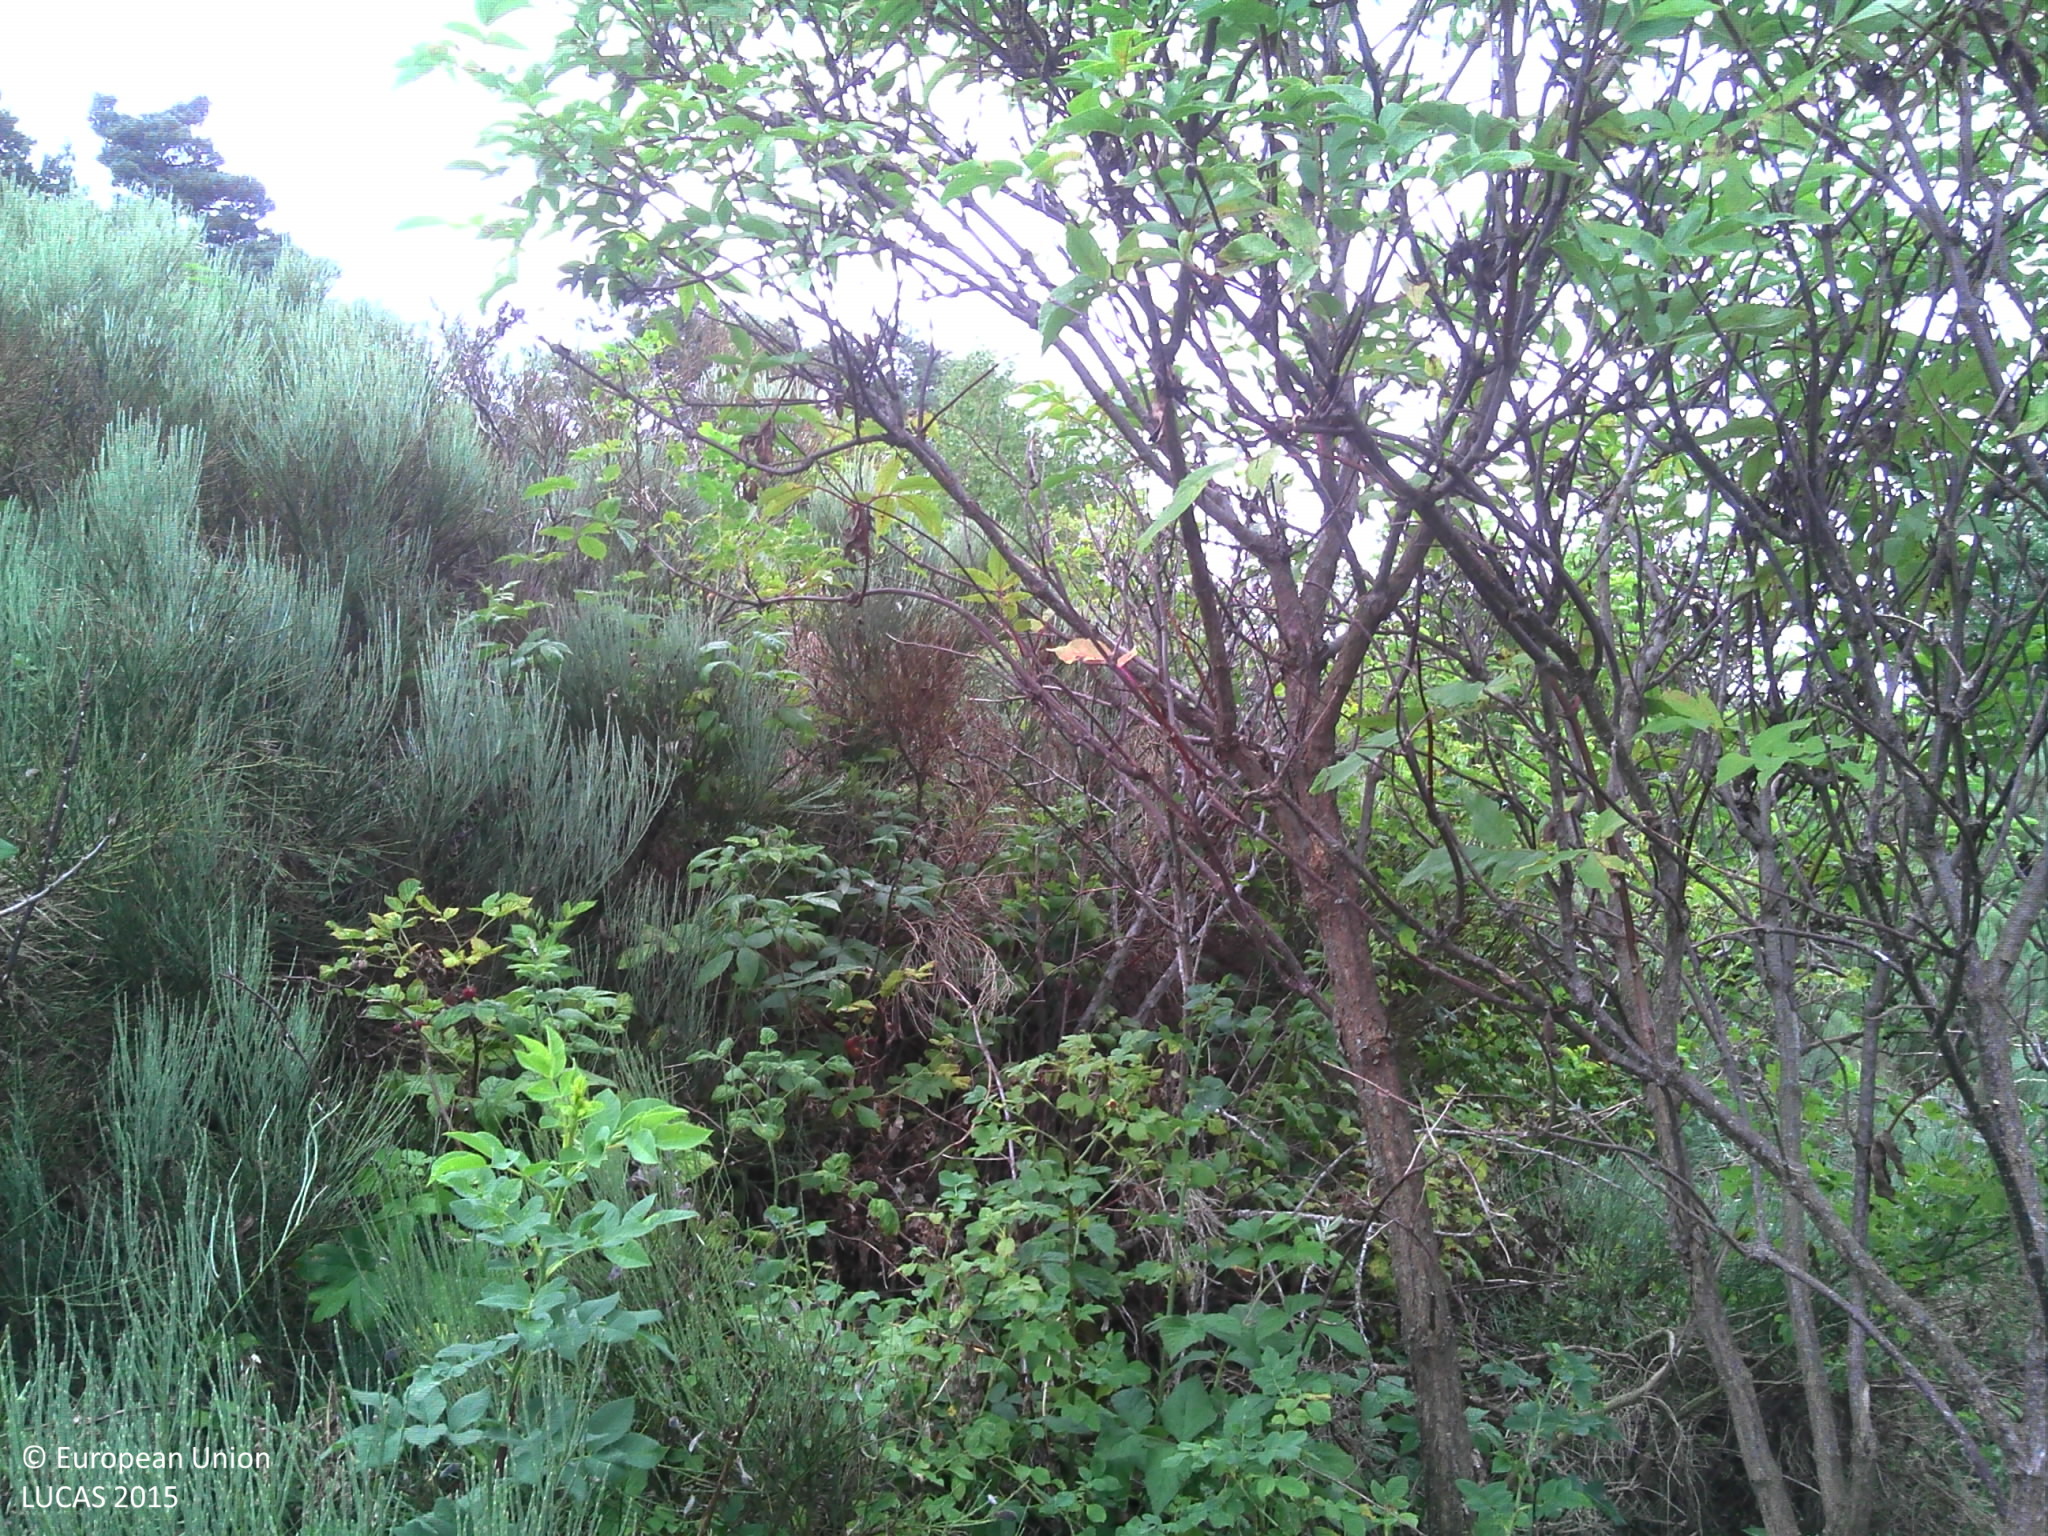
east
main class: Shrubland
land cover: Shrubland without tree cover
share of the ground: > 75 %
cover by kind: shrubs 100 %
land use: Agriculture (excluding fallow land and kitchen gardens)
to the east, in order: Shrubland without tree cover; Fences; Pine dominated mixed woodland; Grassland without tree/shrub cover; Single bushes/trees; Grassland without tree/shrub cover; Grassland with sparse tree/shrub cover
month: July
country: FR
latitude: 44.6507
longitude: 3.4603
